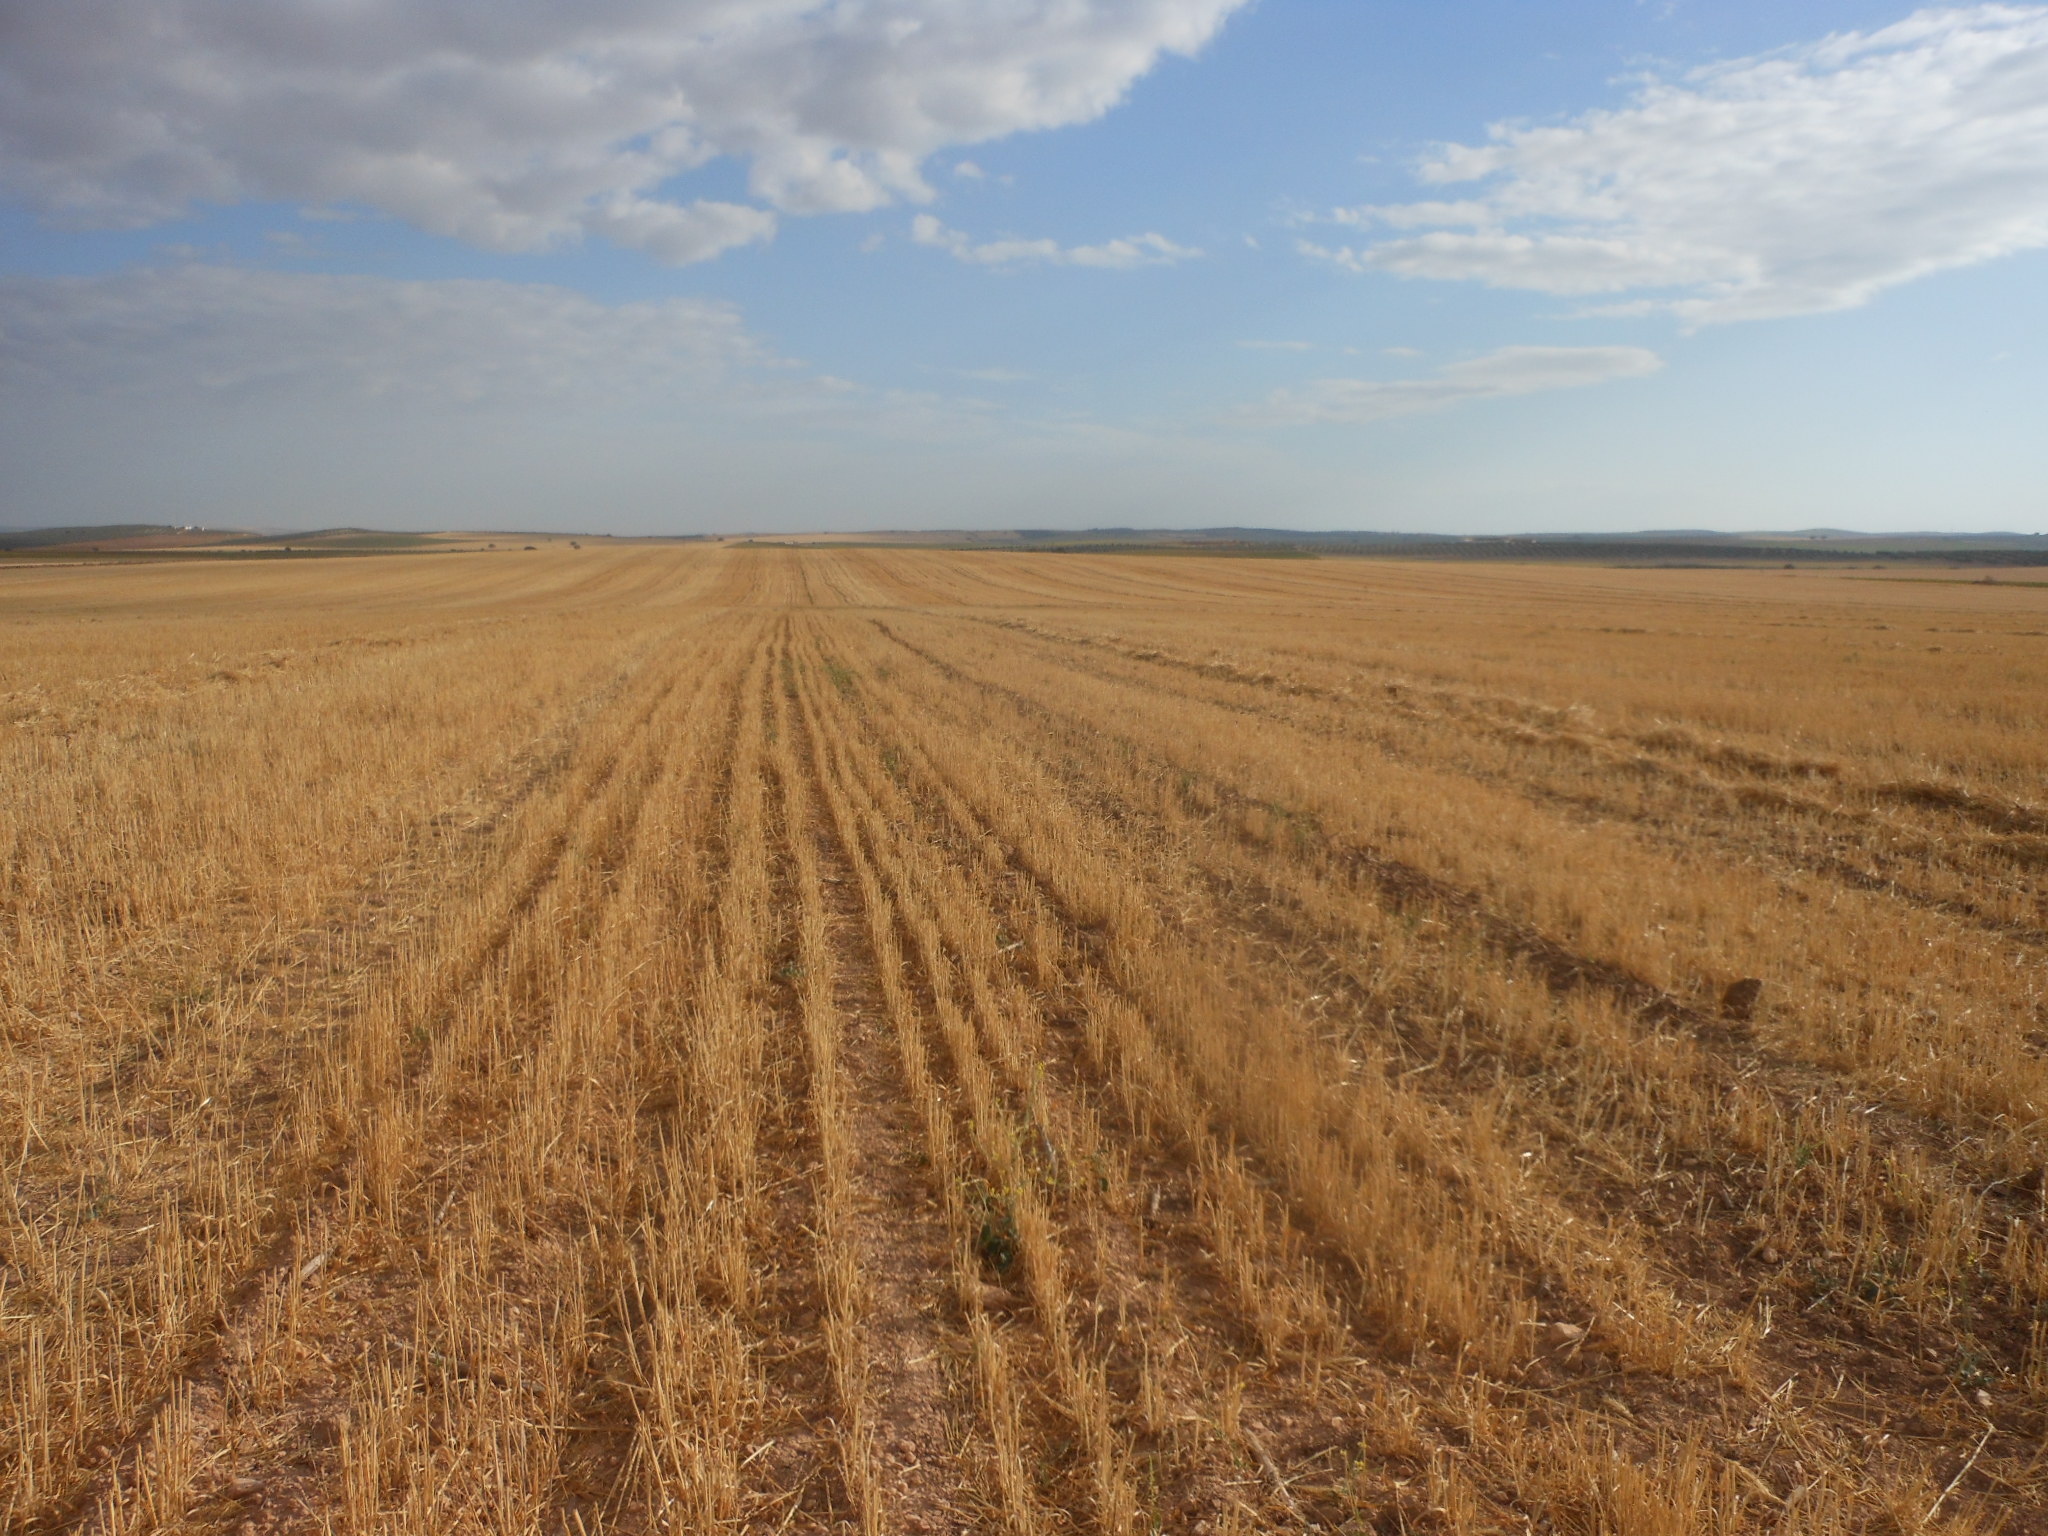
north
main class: Cropland
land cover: Common wheat
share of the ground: < 10 %
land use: Agriculture (excluding fallow land and kitchen gardens)
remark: Harvested field
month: June
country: ES
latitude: 37.3084
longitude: -5.0937
